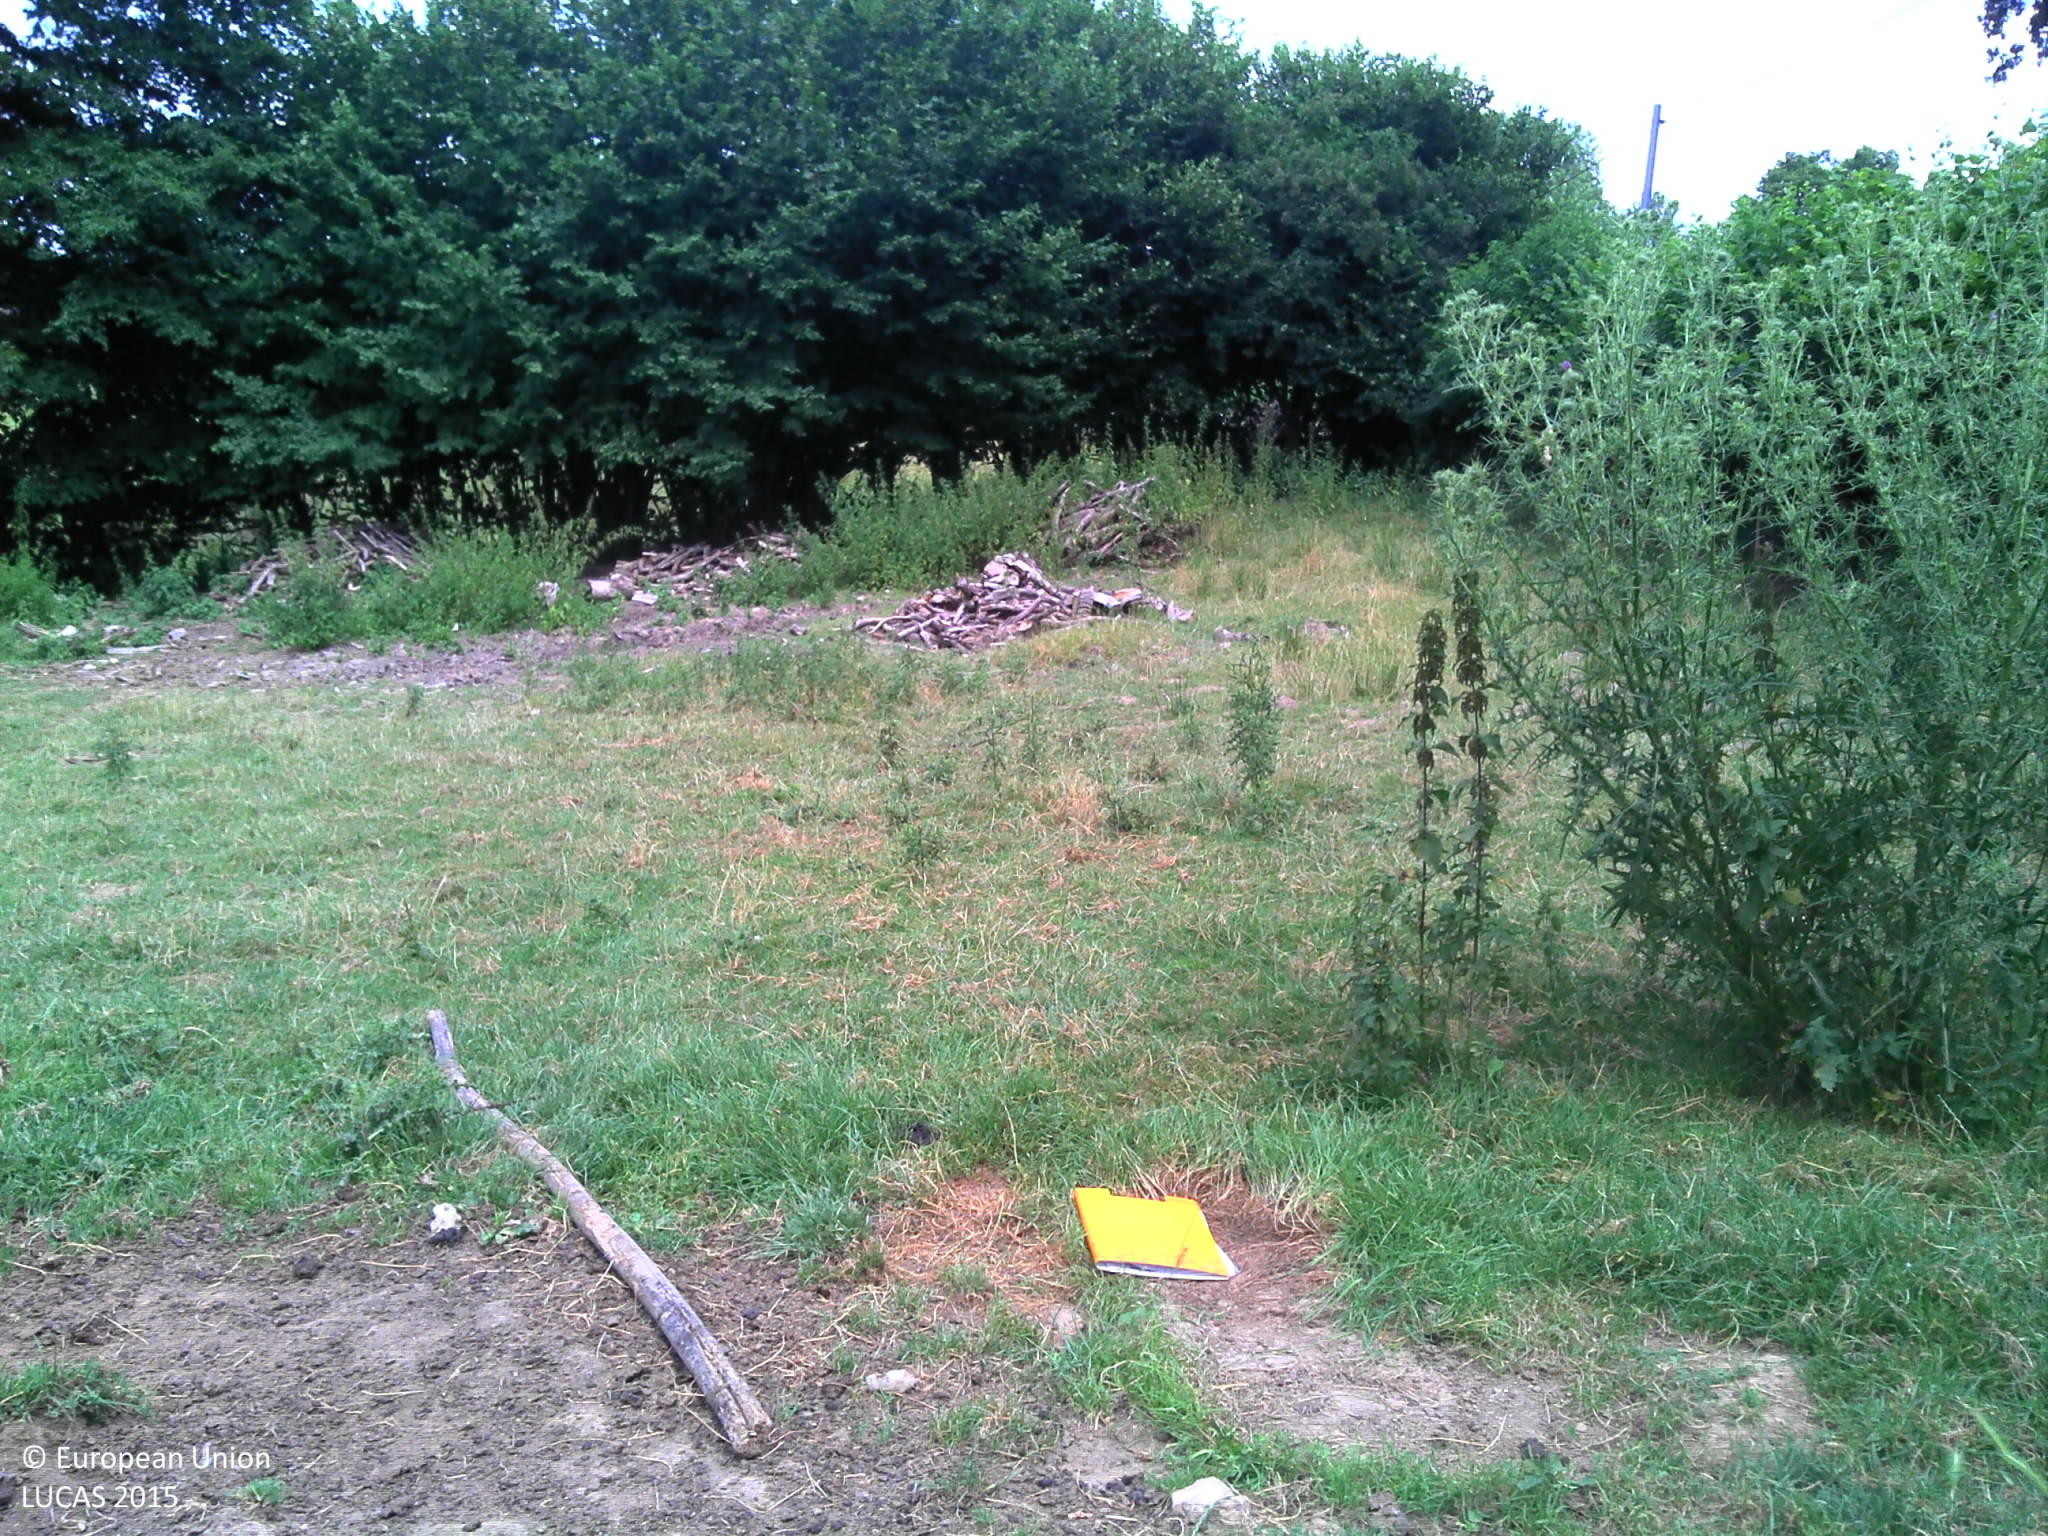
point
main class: Grassland
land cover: Grassland without tree/shrub cover
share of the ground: > 75 %
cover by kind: herbaceous plants 95 %, shrubs 5 %
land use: Agriculture (excluding fallow land and kitchen gardens)
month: July
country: FR
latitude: 46.4117
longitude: 3.0115
